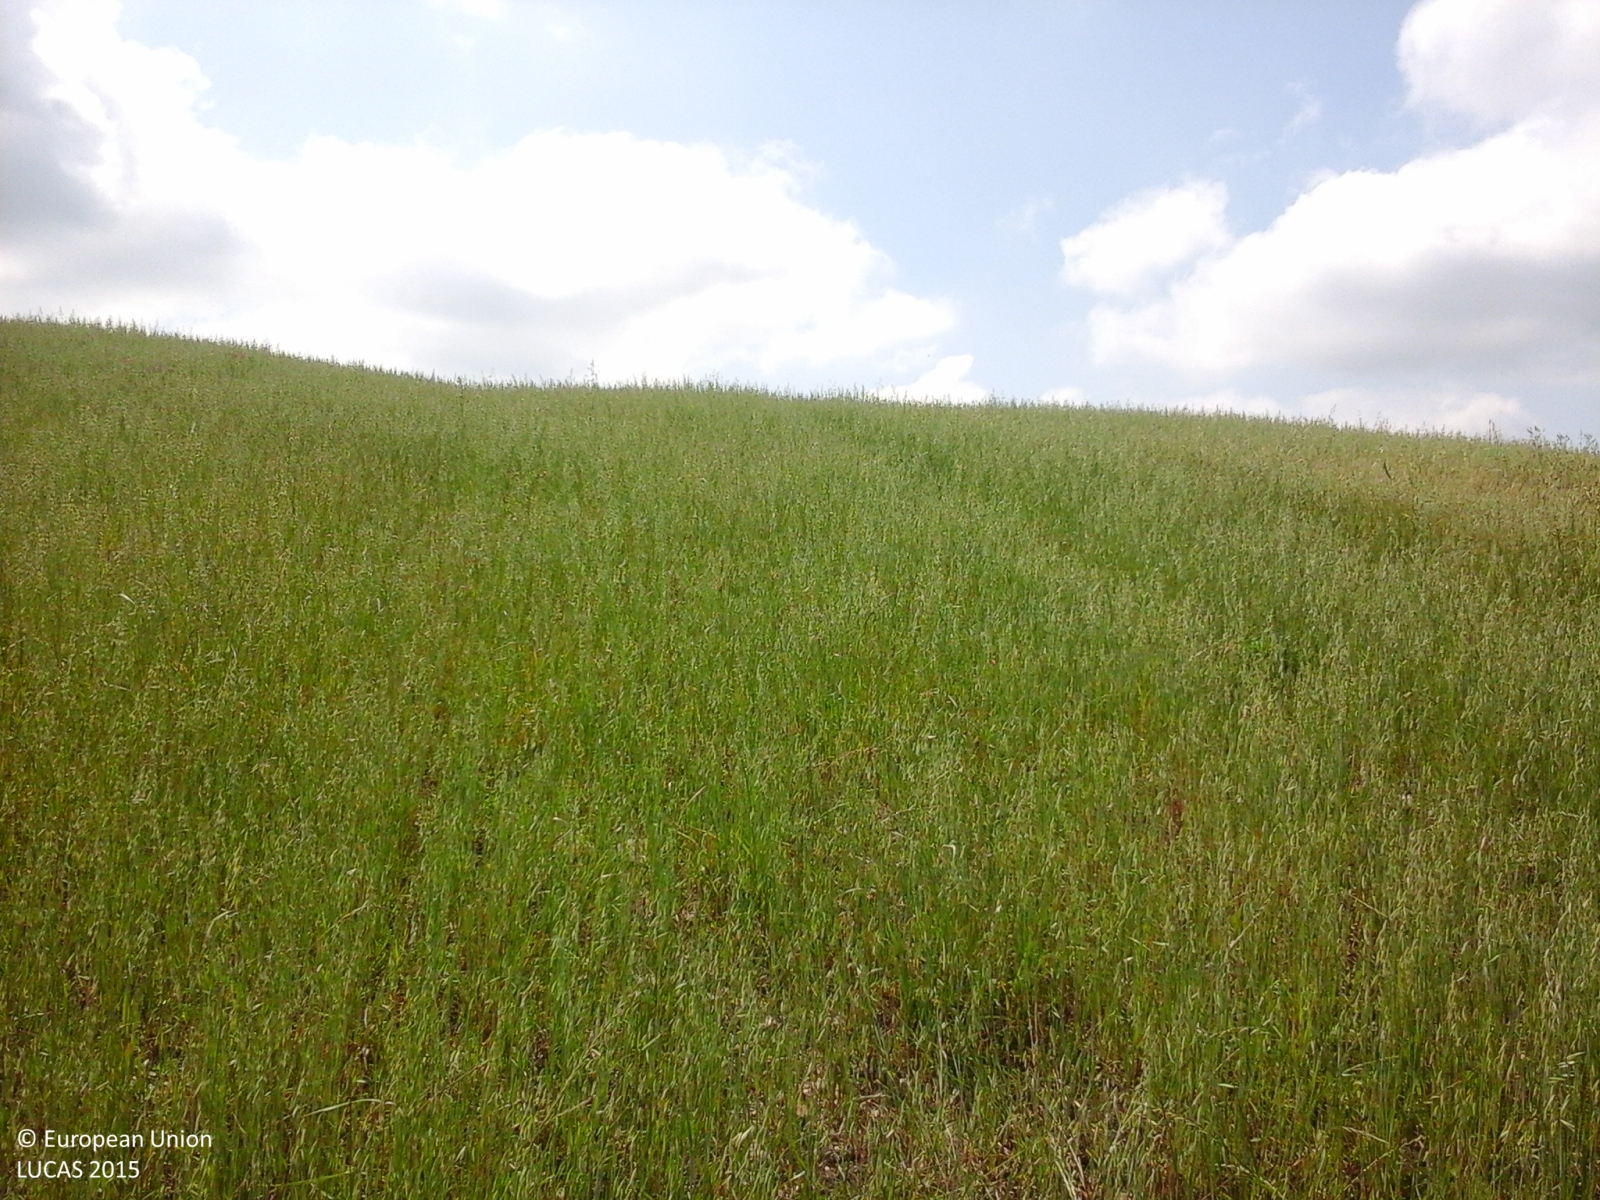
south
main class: Cropland
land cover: Oats
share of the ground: > 75 %
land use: Agriculture (excluding fallow land and kitchen gardens)
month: May
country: IT
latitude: 41.2221
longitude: 15.0990
